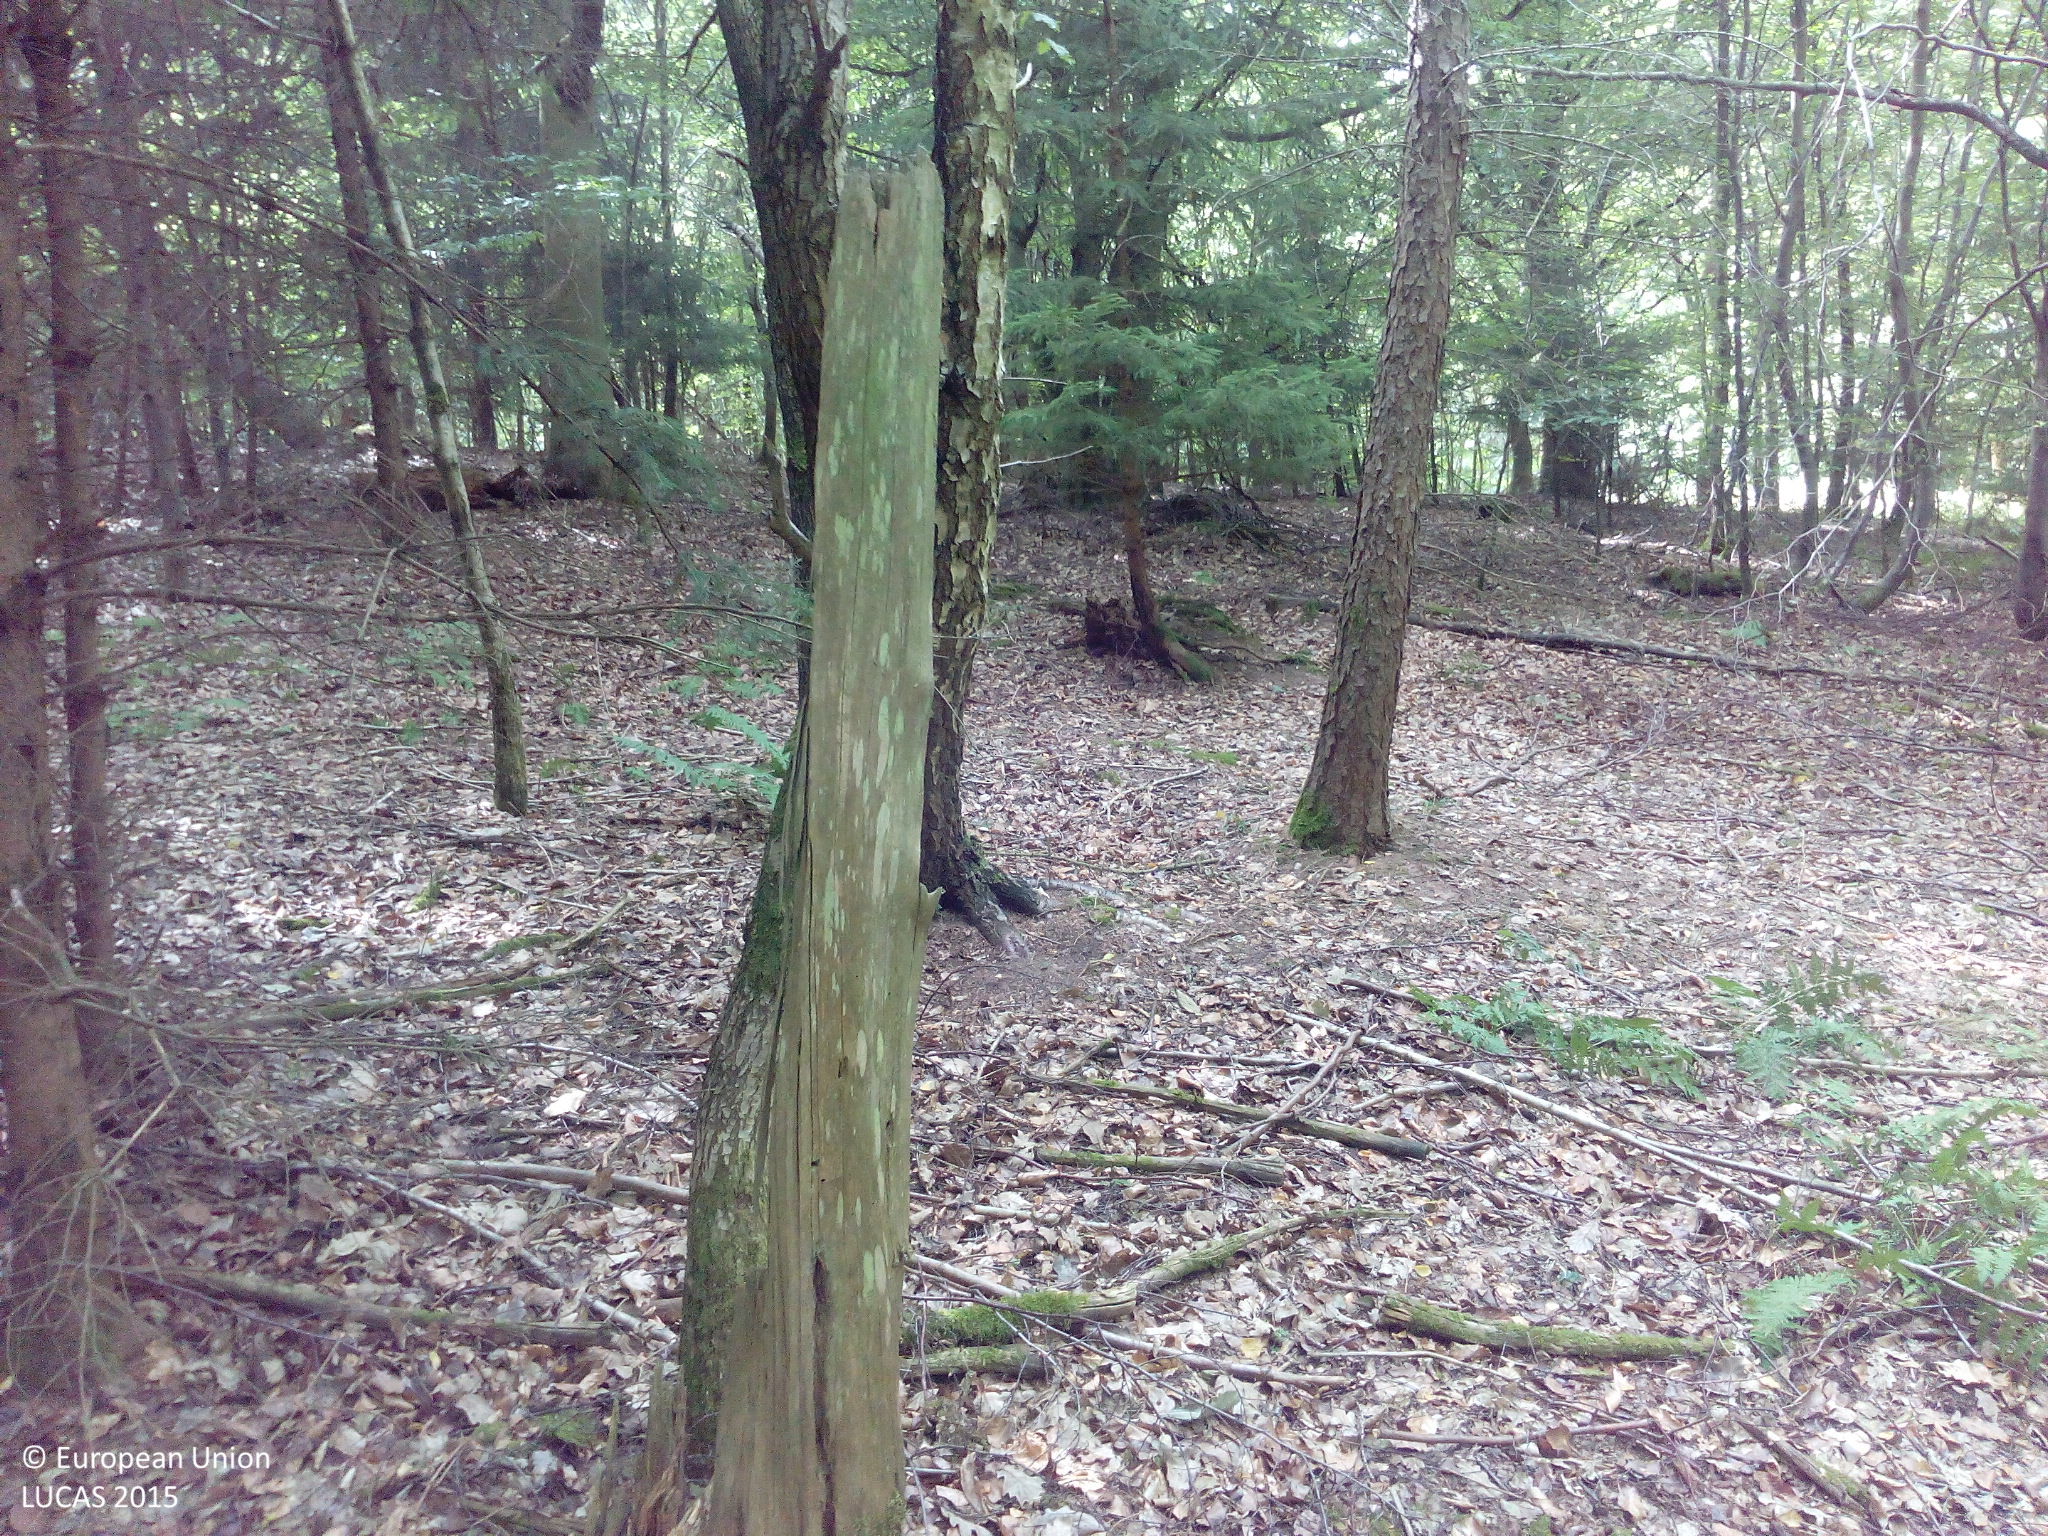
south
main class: Woodland
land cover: Spruce dominated mixed woodland
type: mesophytic deciduous forest
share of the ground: > 75 %
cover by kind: broadleaved forest trees 65 %, coniferous forest trees 25 %, lichens and mosses 5 %, unconsolidated bare surface 5 %
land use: Forestry
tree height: > 5 m
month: August
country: DE
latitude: 49.7254
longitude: 7.5173
